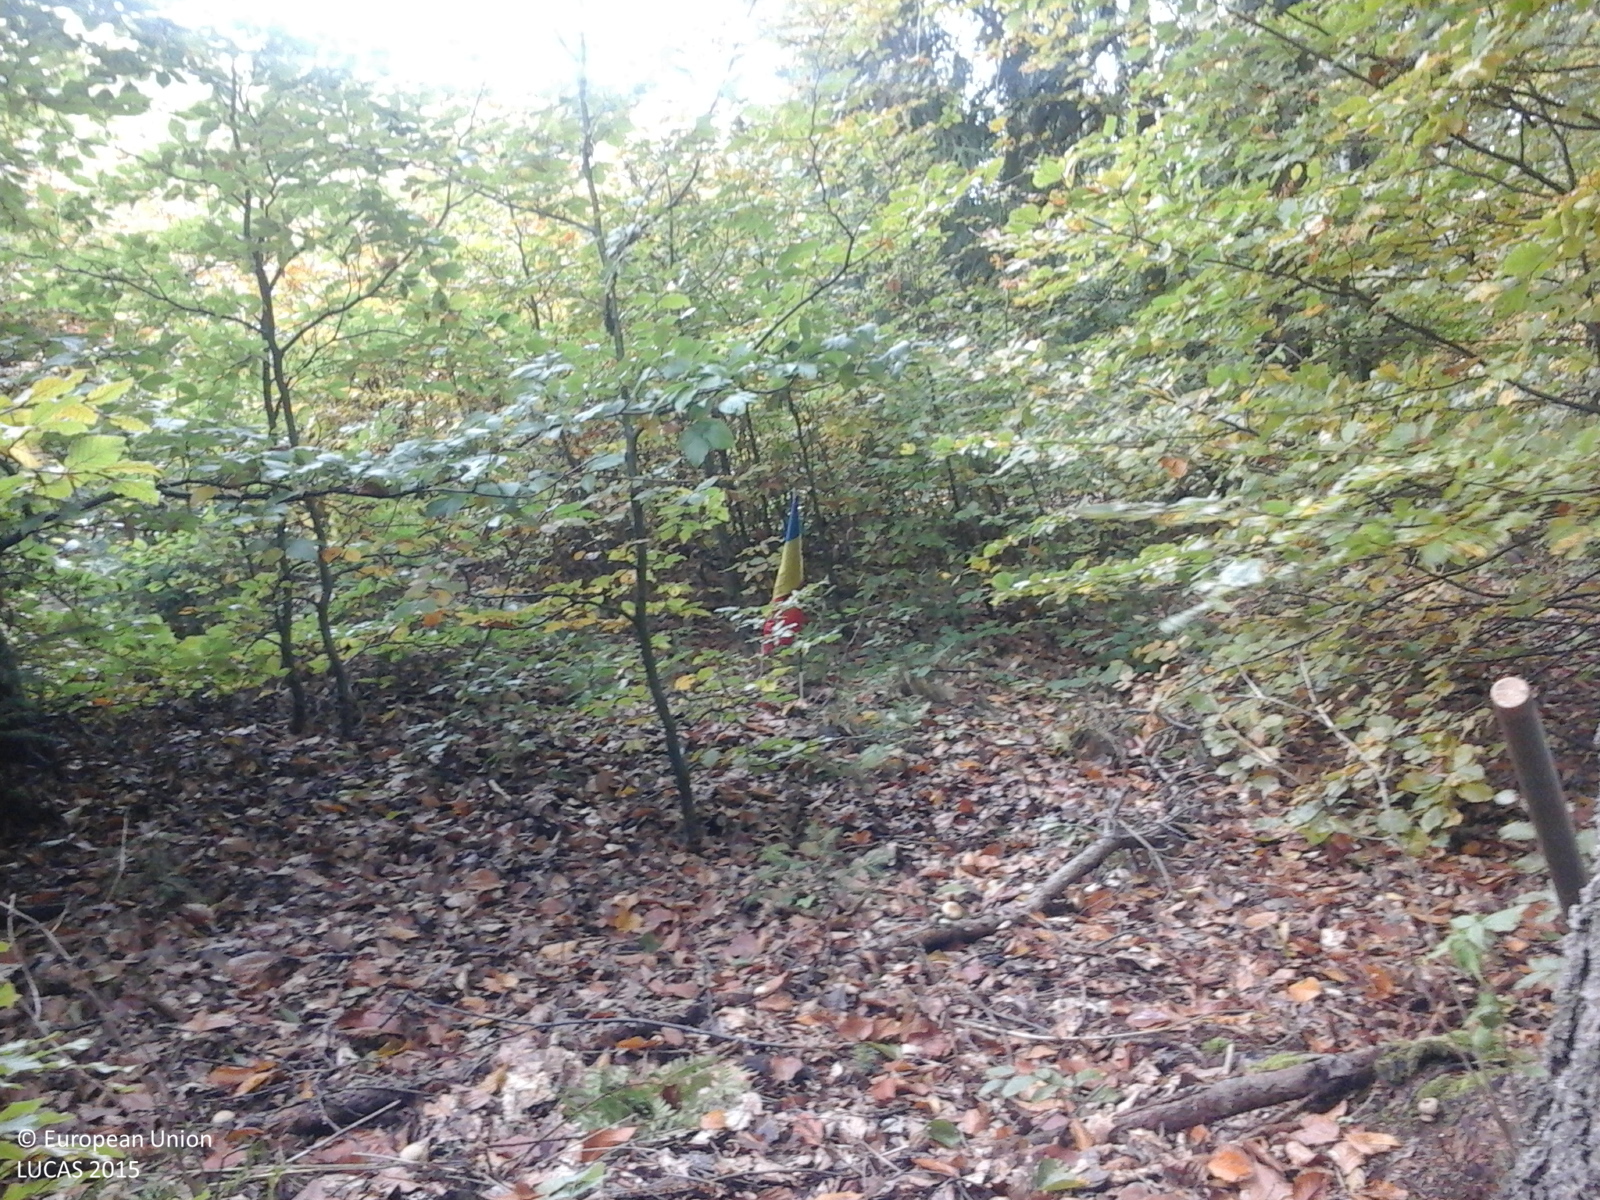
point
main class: Woodland
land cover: Other mixed woodland
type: alpine coniferous forest
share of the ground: > 75 %
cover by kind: coniferous forest trees 60 %, broadleaved forest trees 40 %
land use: Forestry
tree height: > 5 m
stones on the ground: 10 - 25 %
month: October
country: RO
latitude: 46.5507
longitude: 25.2455
